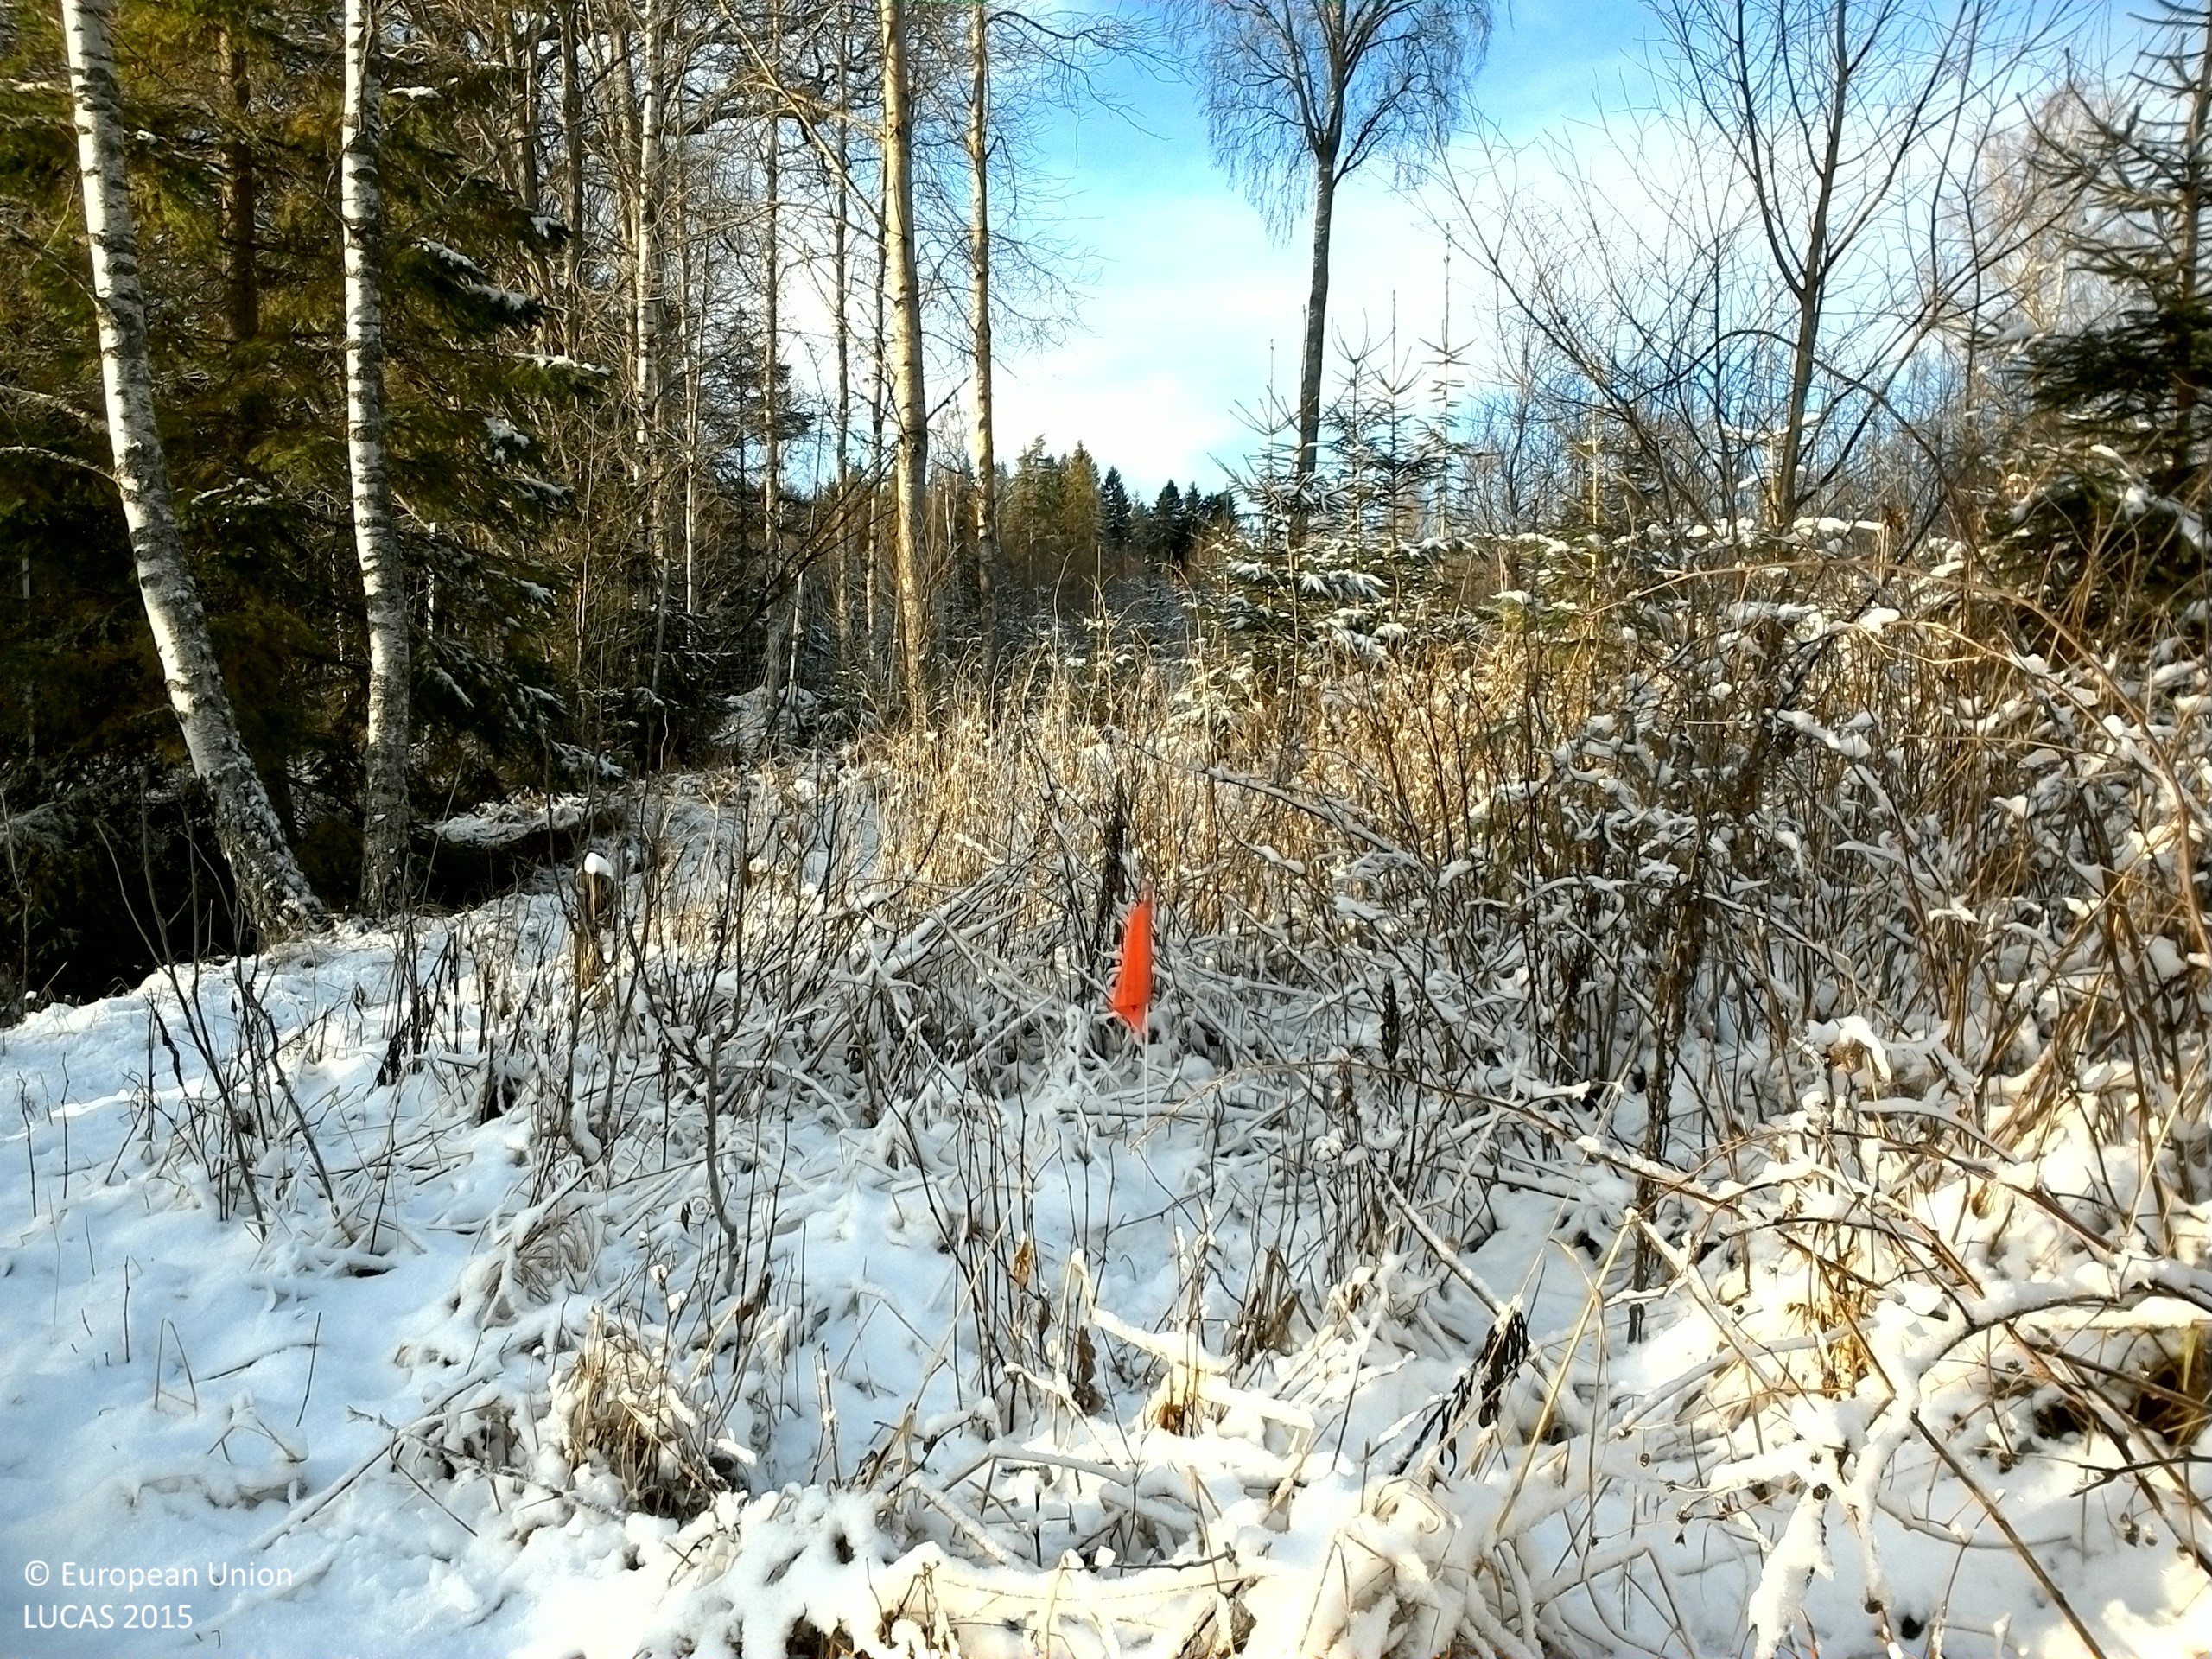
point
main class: Woodland
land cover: Spruce dominated mixed woodland
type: boreal forest
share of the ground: 50 - 75 %
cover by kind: broadleaved forest trees 40 %, shrubs 30 %, coniferous forest trees 20 %, herbaceous plants 10 %
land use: Forestry
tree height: > 5 m
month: December
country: SE
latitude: 59.6854
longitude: 16.5460
